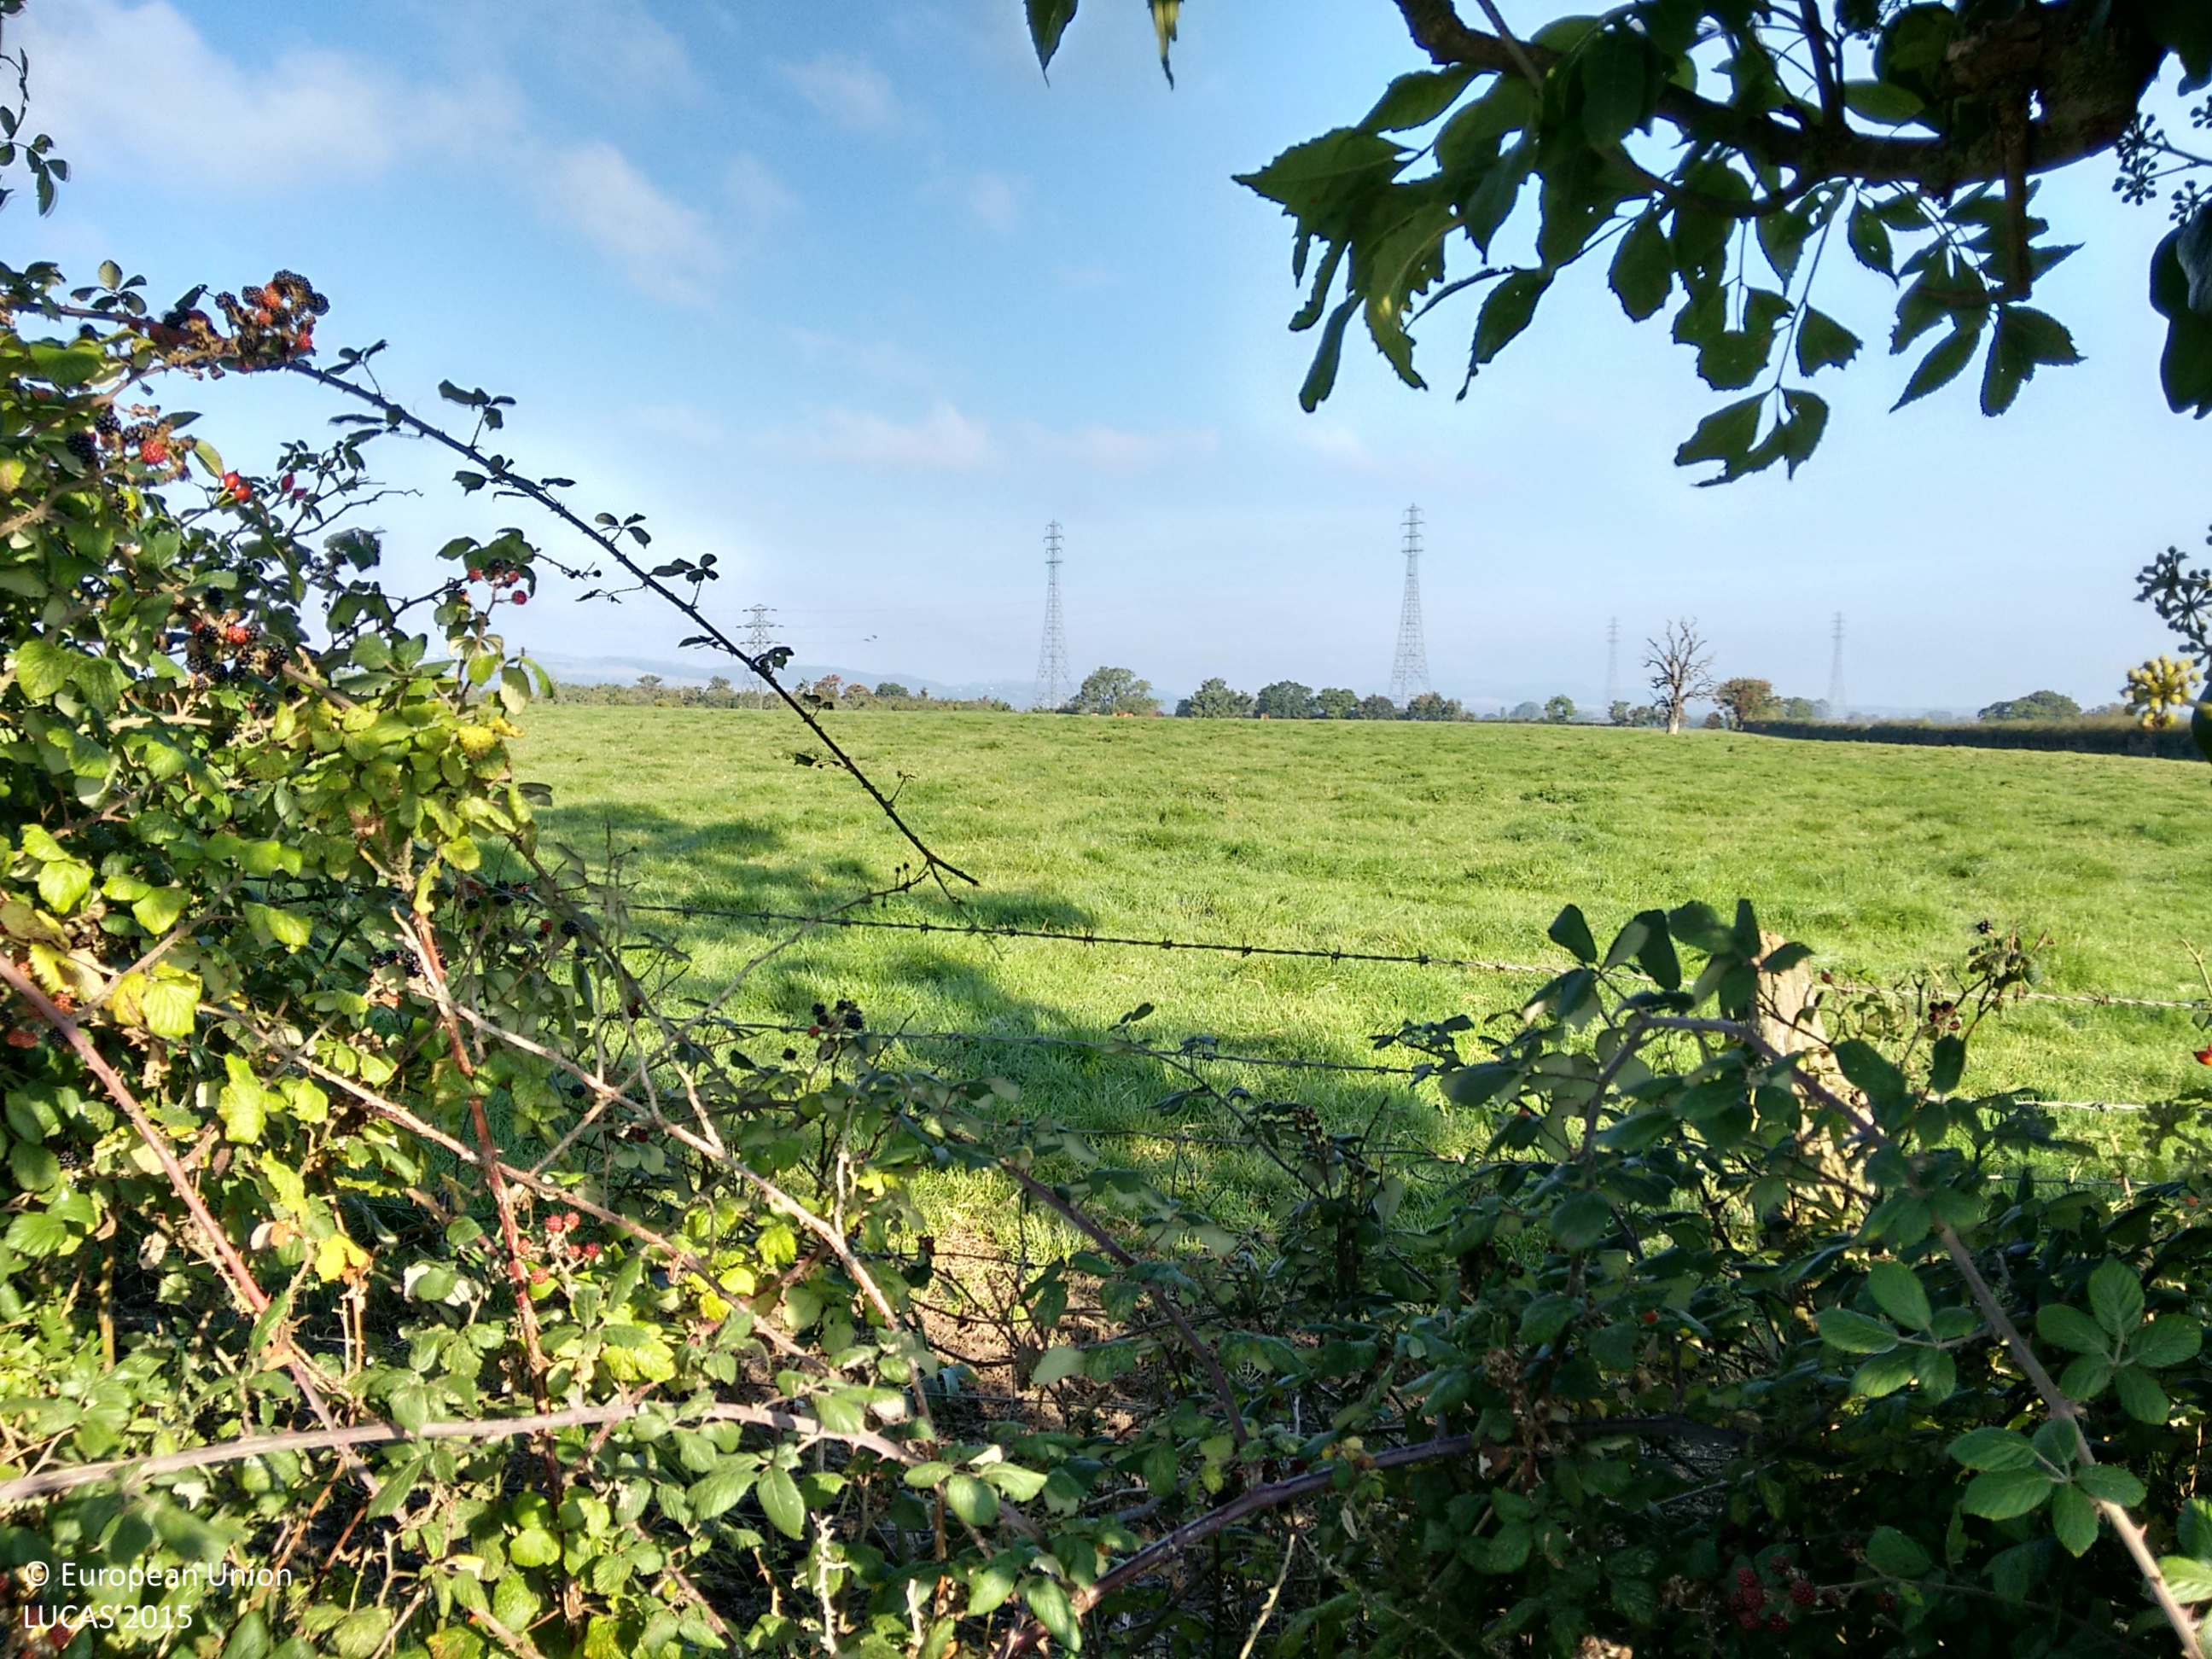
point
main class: Grassland
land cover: Grassland without tree/shrub cover
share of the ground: > 75 %
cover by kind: herbaceous plants 100 %
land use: Agriculture (excluding fallow land and kitchen gardens)
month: September
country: GB
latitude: 51.7758
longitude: -2.4281
